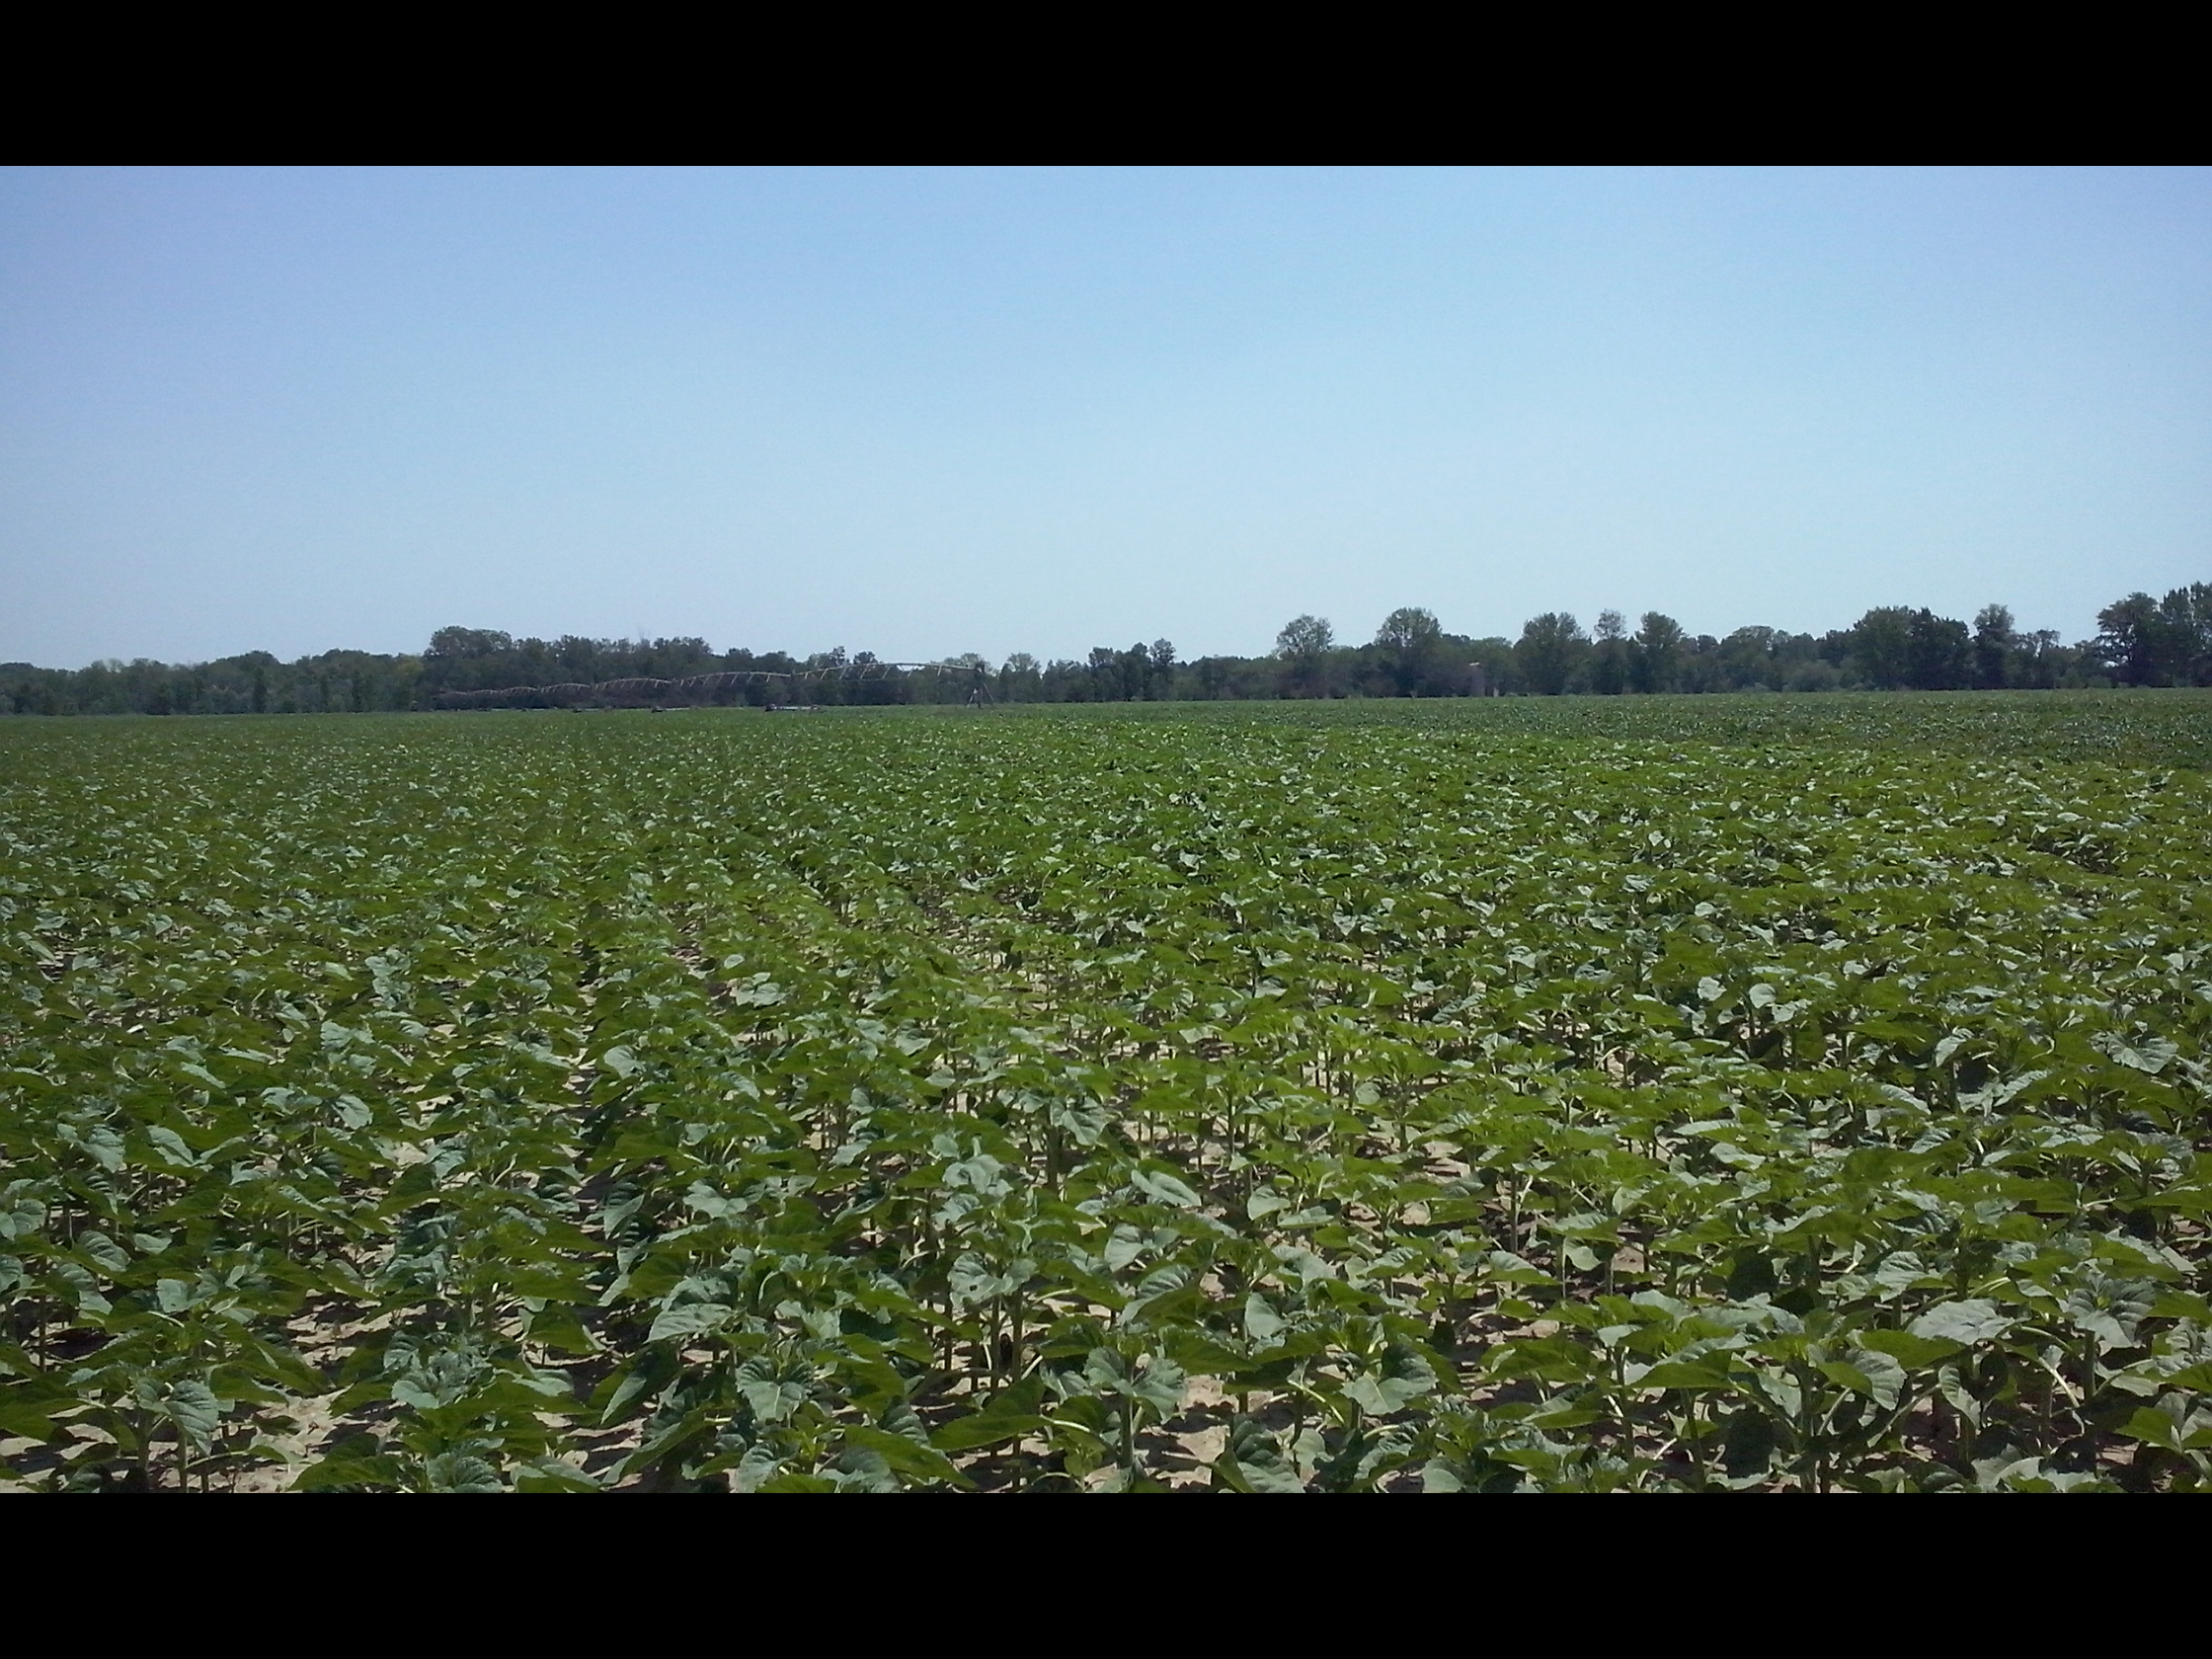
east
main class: Cropland
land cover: Sunflower
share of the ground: > 75 %
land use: Agriculture (excluding fallow land and kitchen gardens)
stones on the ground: < 10 %
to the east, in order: Sunflower; Sugar beet
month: June
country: ES
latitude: 41.4809
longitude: -5.0791
